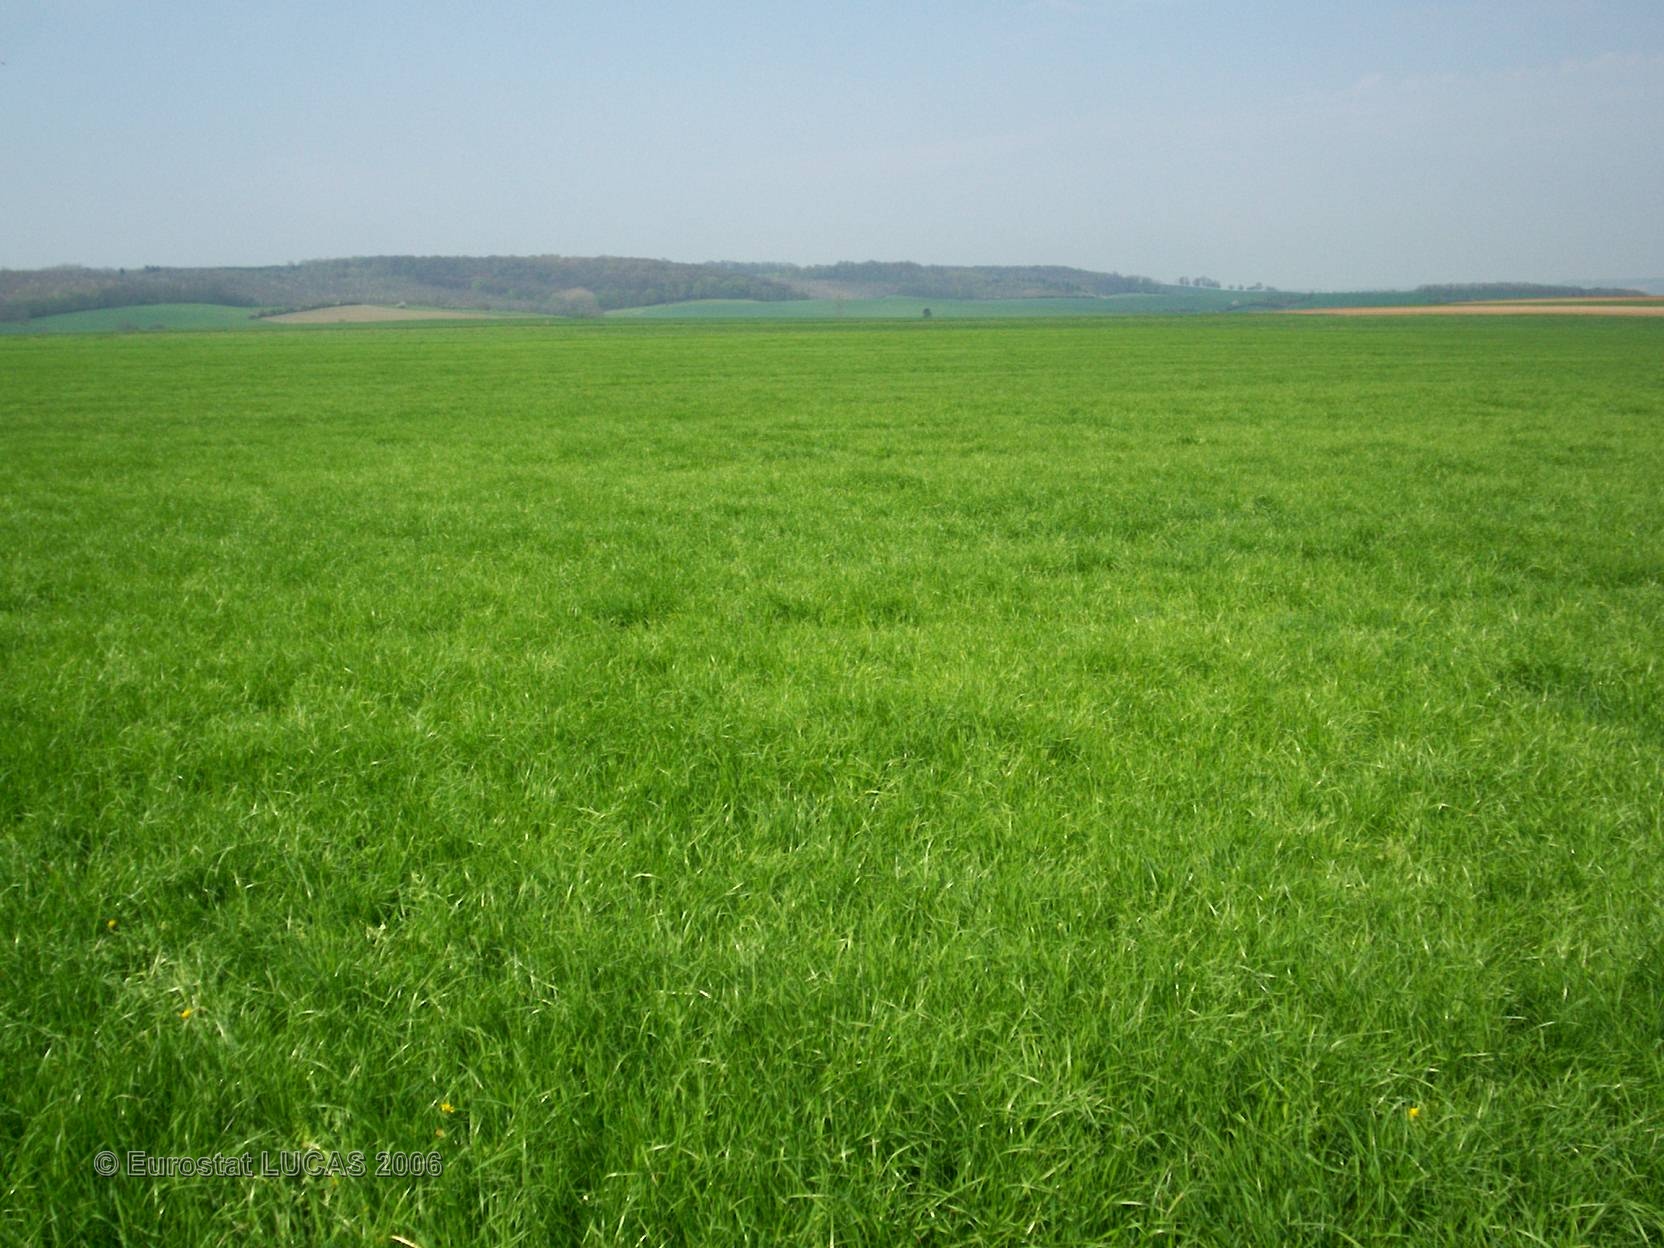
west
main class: Grassland
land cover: Grassland without tree/shrub cover
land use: Agriculture (excluding fallow land and kitchen gardens)
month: April
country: FR
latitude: 48.7633
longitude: 6.5312
